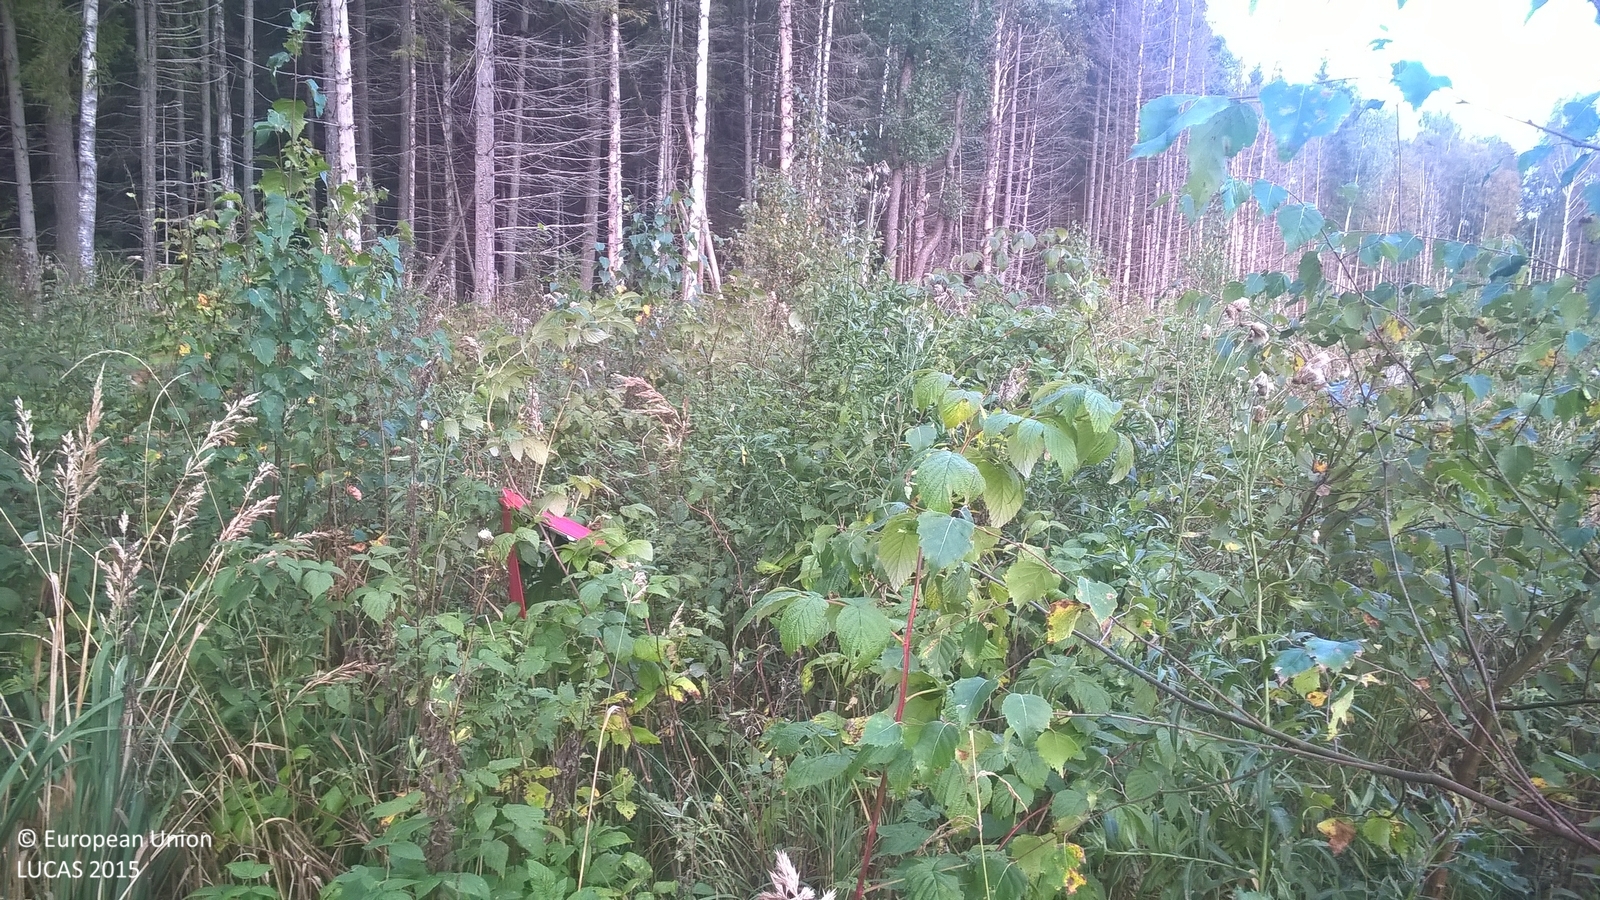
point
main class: Shrubland
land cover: Shrubland with sparse tree cover
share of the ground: > 75 %
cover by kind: shrubs 95 %, broadleaved forest trees 5 %
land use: Forestry
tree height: < 5 m
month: September
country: LV
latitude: 57.8396
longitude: 25.6989
